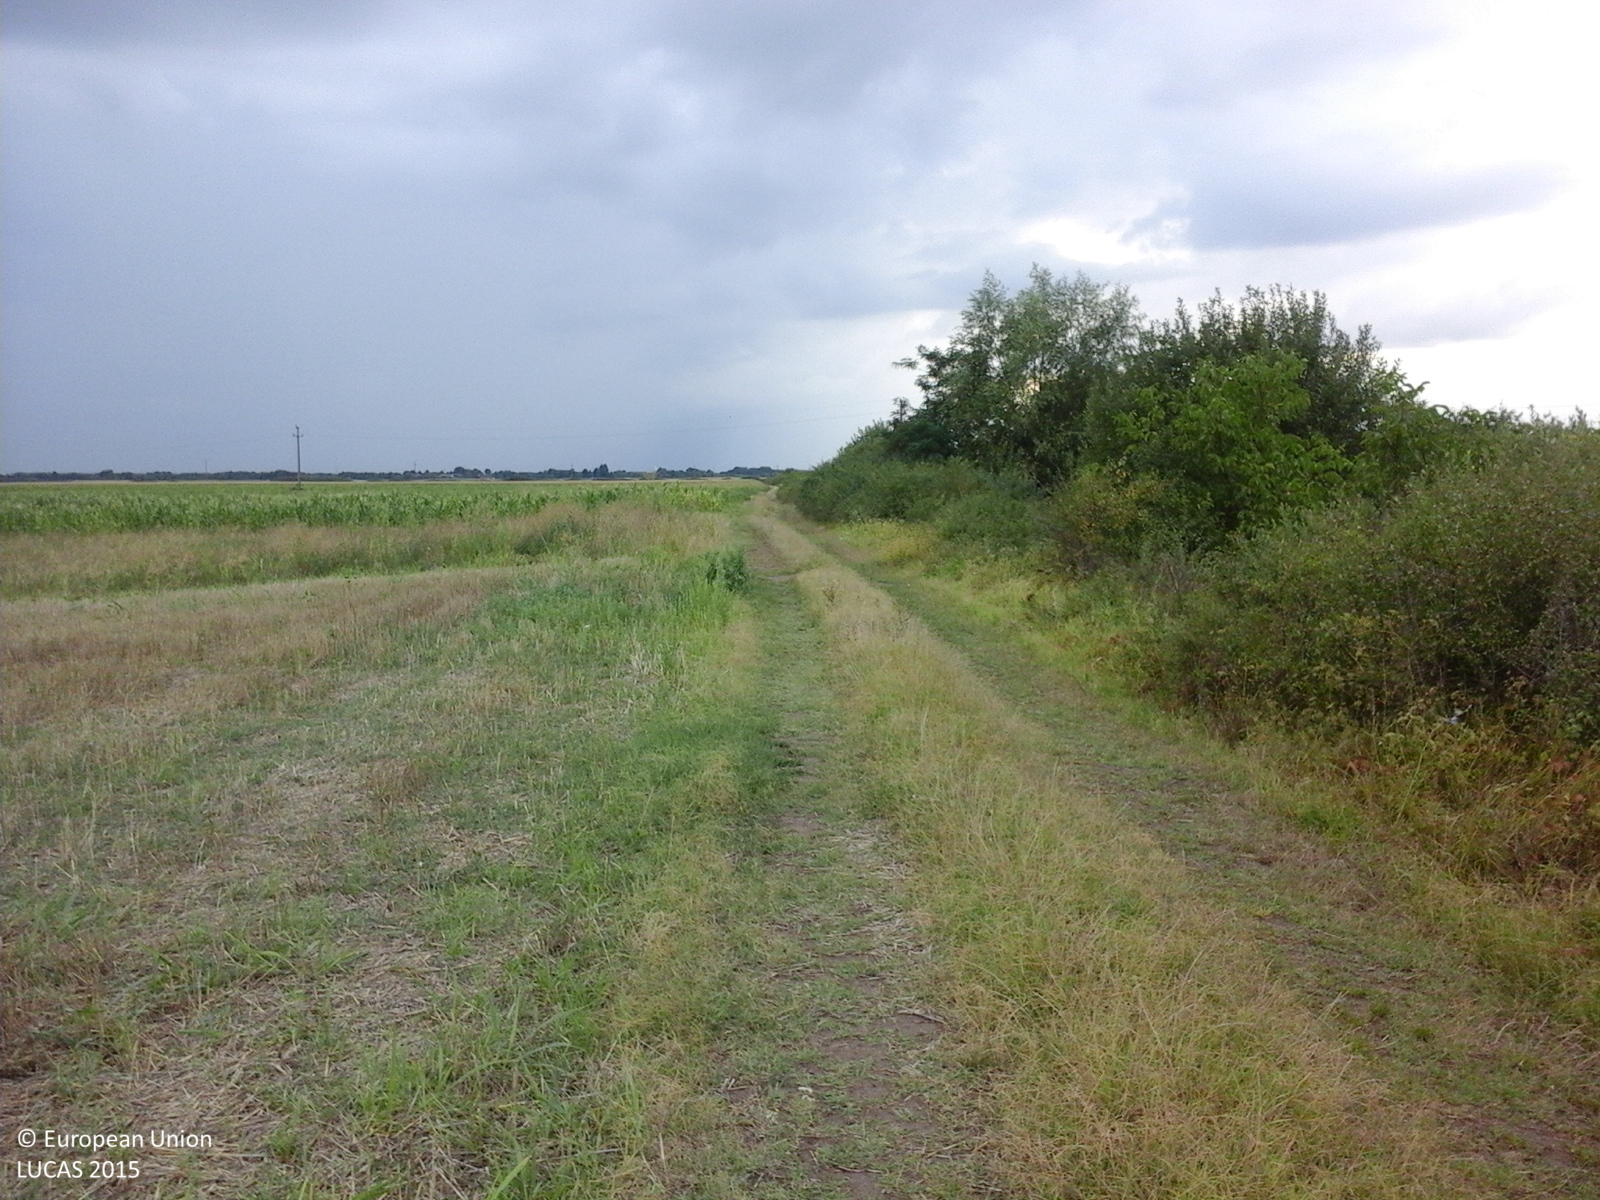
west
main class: Woodland
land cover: Broadleaved woodland
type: exotic forest
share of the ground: > 75 %
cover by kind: broadleaved forest trees 100 %
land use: Forestry
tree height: > 5 m
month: August
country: RO
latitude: 45.6472
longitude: 21.4133
